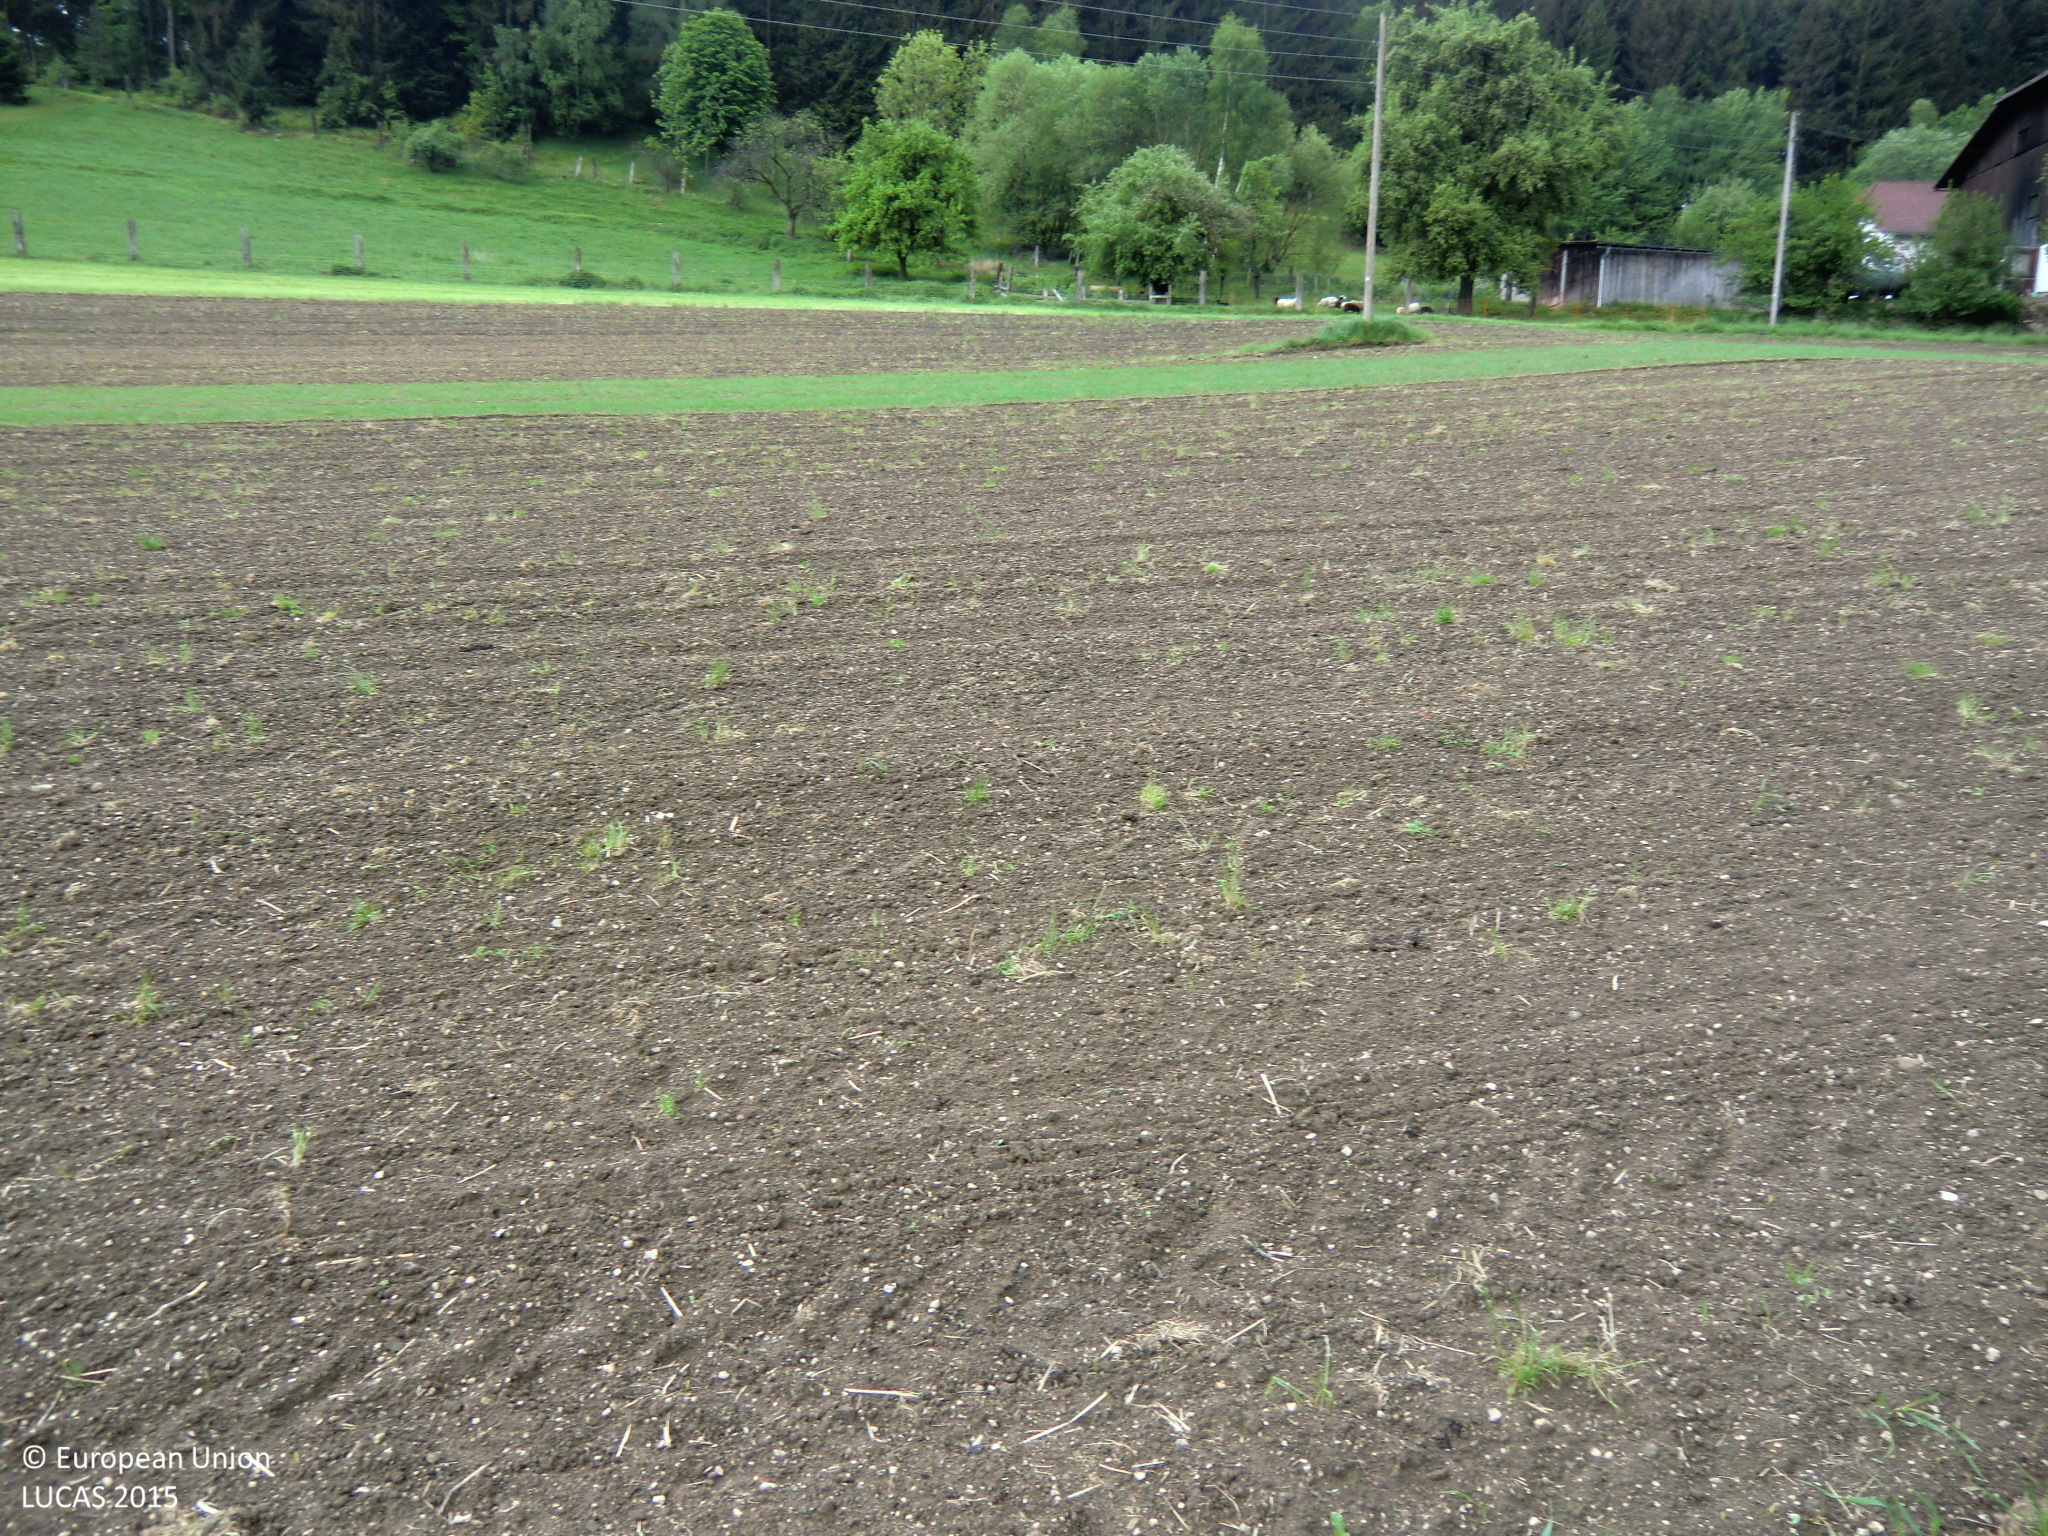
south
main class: Cropland
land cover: Maize
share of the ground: < 10 %
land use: Agriculture (excluding fallow land and kitchen gardens)
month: May
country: AT
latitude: 48.4761
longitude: 14.4511
